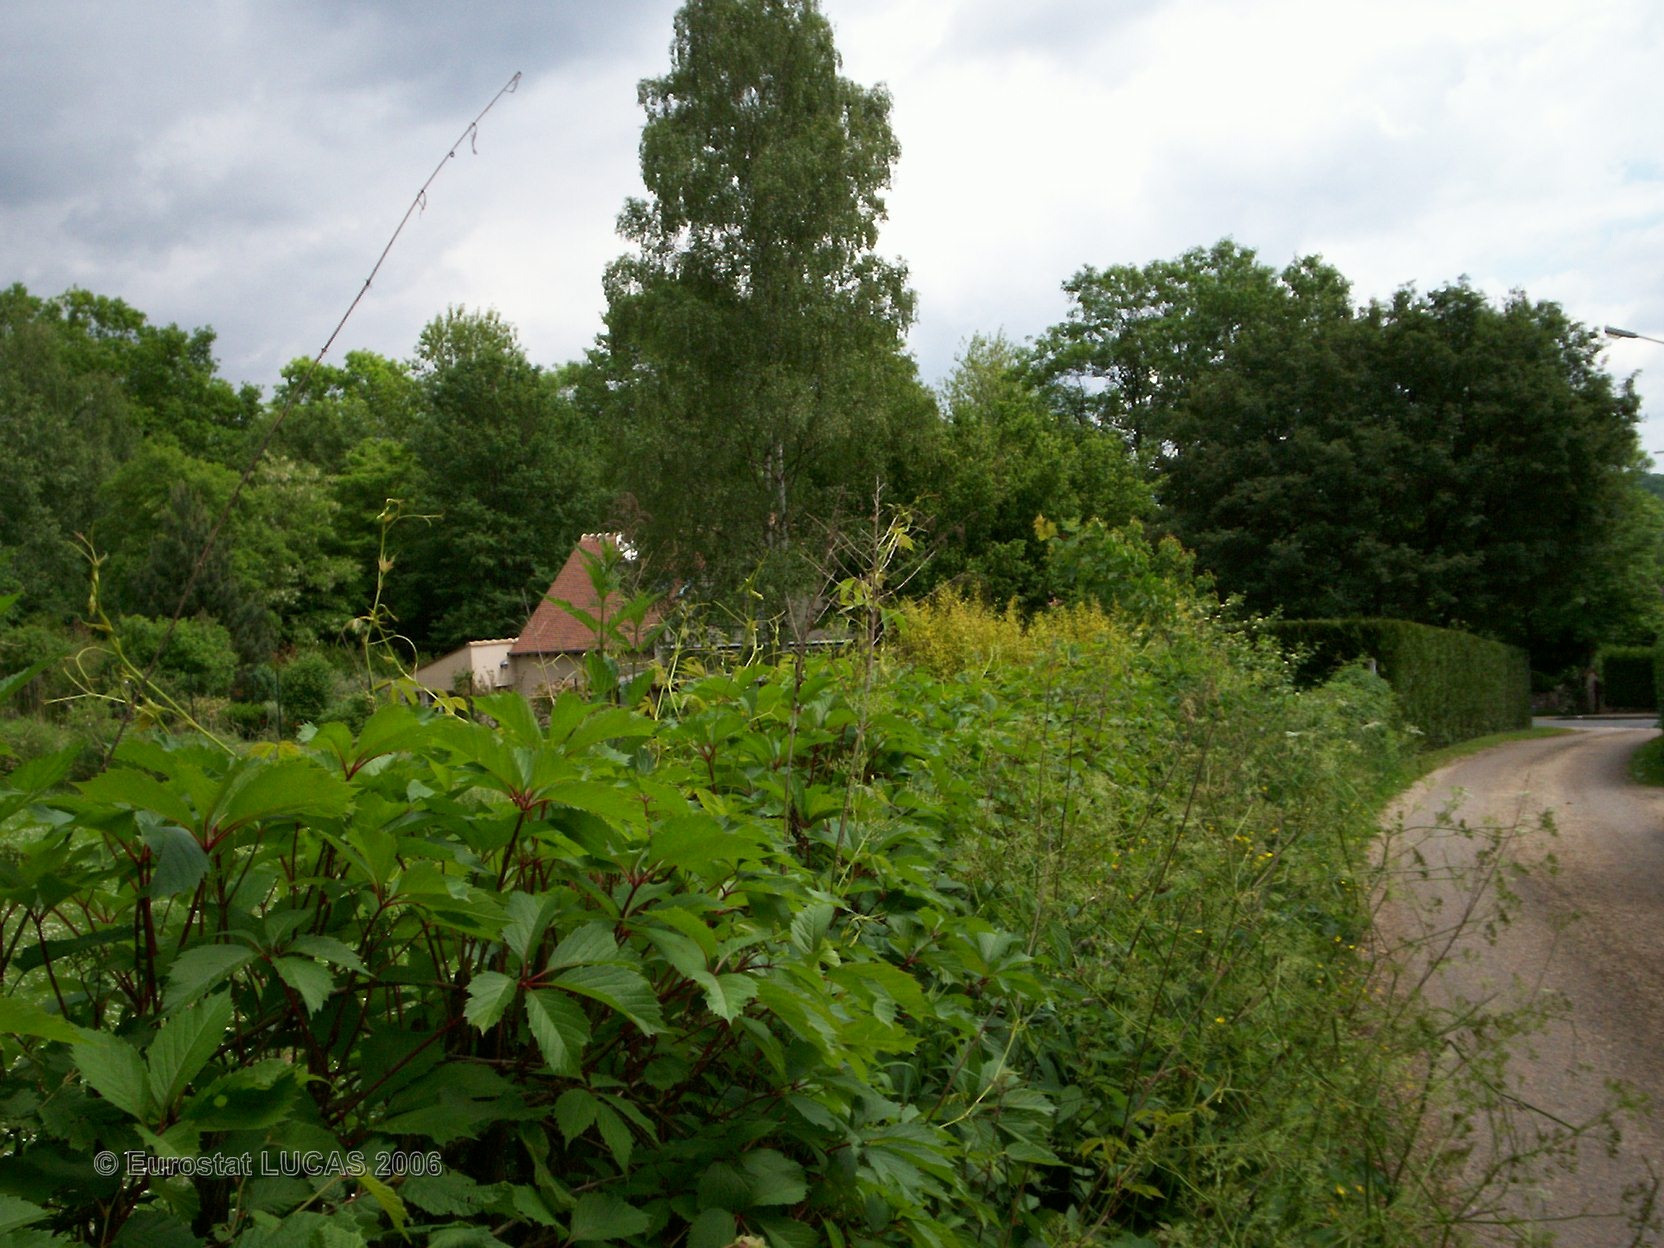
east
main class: Grassland
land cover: Grassland with sparse tree/shrub cover
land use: Residential
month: May
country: FR
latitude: 48.4548
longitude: 2.7567
